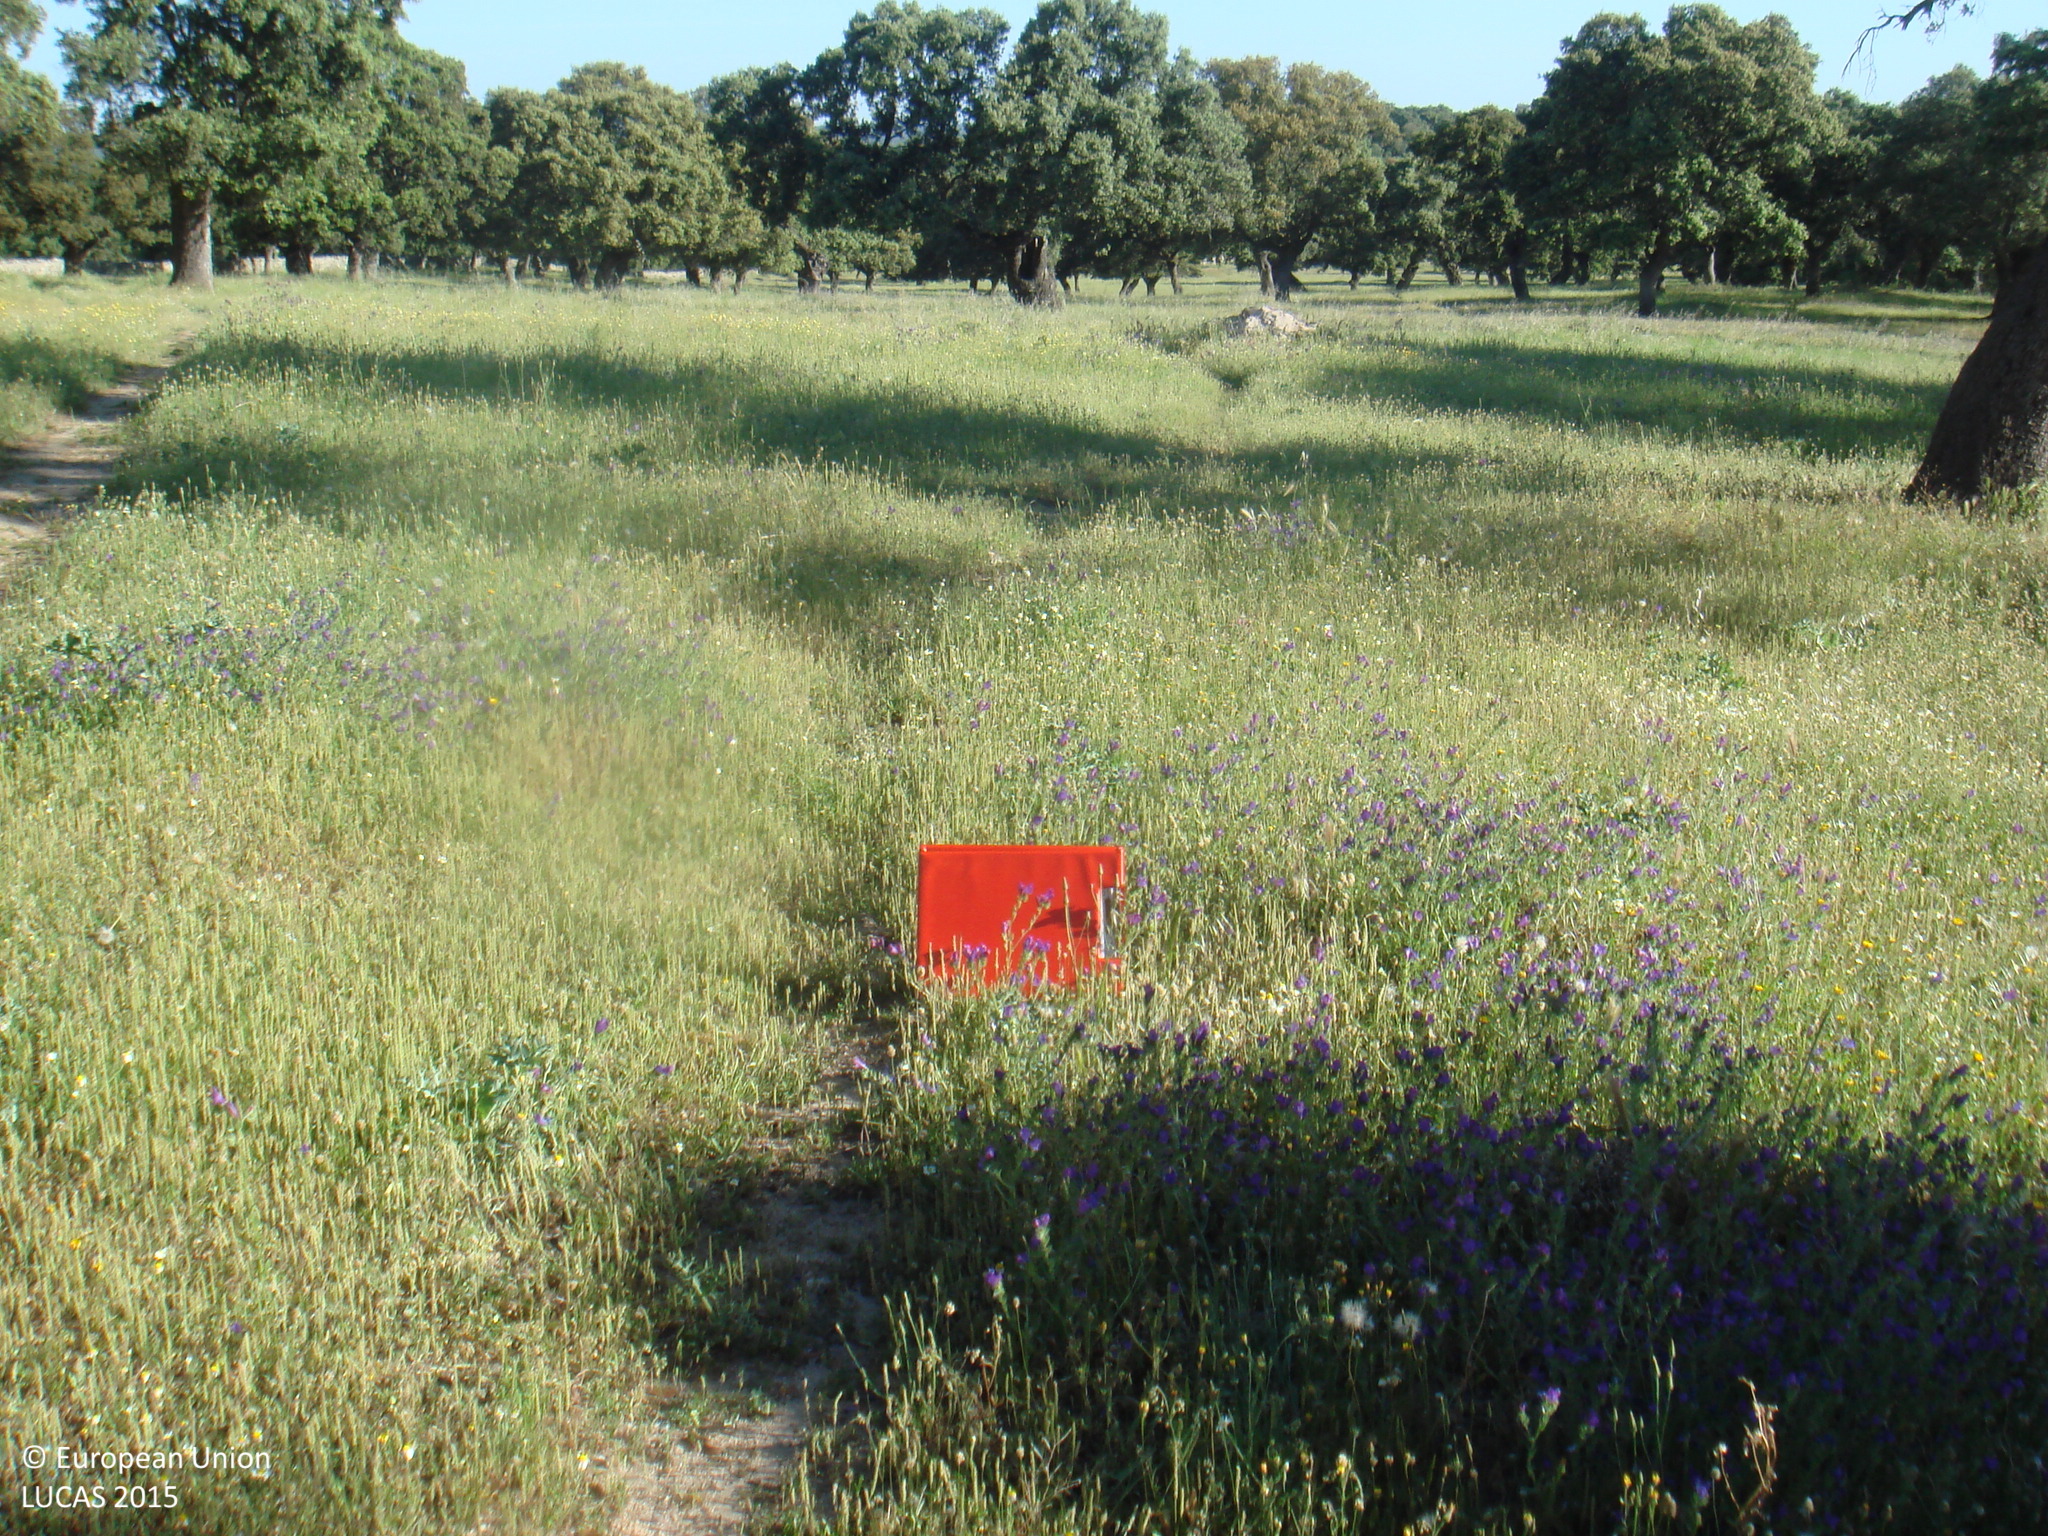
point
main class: Woodland
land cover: Broadleaved woodland
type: broadleaved evergreen forest
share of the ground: 50 - 75 %
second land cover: Spontaneously vegetated surfaces
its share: > 75 %
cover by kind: broadleaved forest trees 50 %, herbaceous plants 50 %
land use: Forestry
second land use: Agriculture (excluding fallow land and kitchen gardens)
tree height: > 5 m
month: May
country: ES
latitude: 38.3203
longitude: -4.7417
